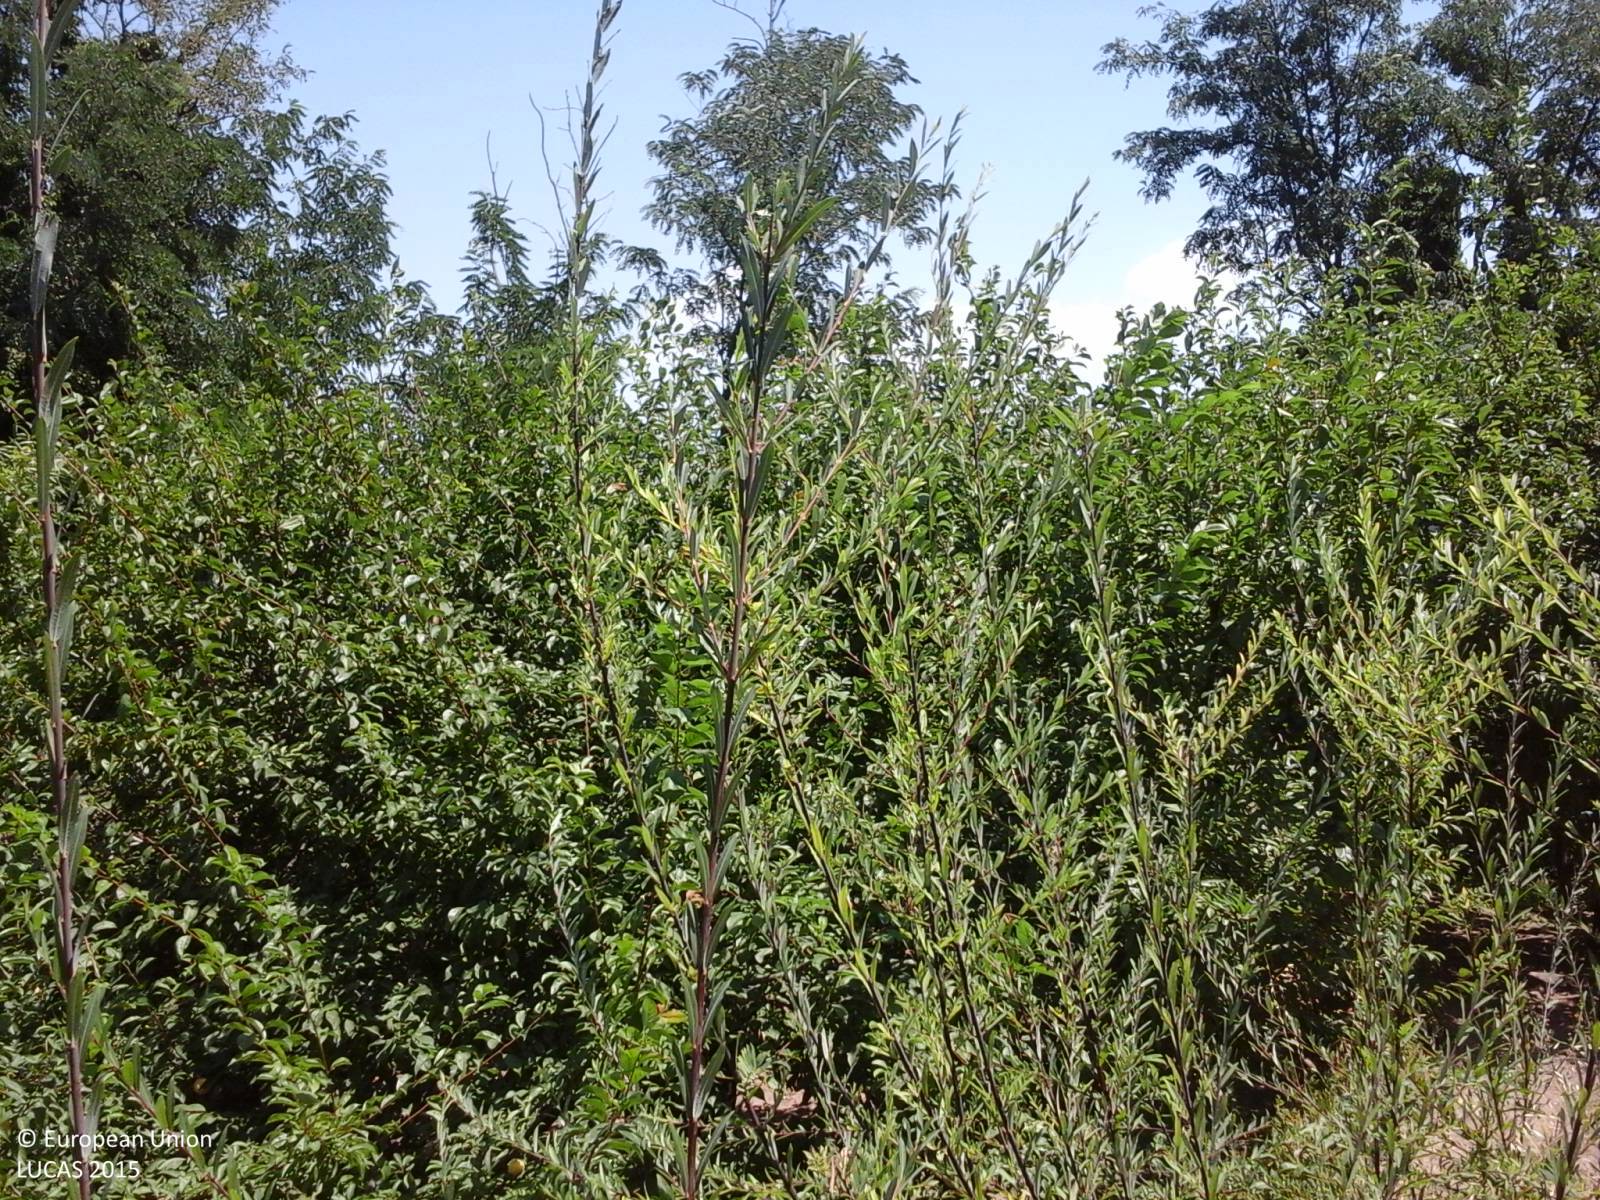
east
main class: Shrubland
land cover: Shrubland with sparse tree cover
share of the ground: > 75 %
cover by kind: shrubs 60 %, herbaceous plants 35 %, broadleaved forest trees 5 %
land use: Agriculture (excluding fallow land and kitchen gardens)
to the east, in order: Shrubland with sparse tree cover; Other fruit trees and berries; Broadleaved woodland; Artificial constructions in urban areas; Grassland with sparse tree/shrub cover; Artificial constructions in urban areas; Permanent crops (only in case pi); Artificial constructions in urban areas
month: July
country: IT
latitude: 40.8691
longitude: 14.1236
